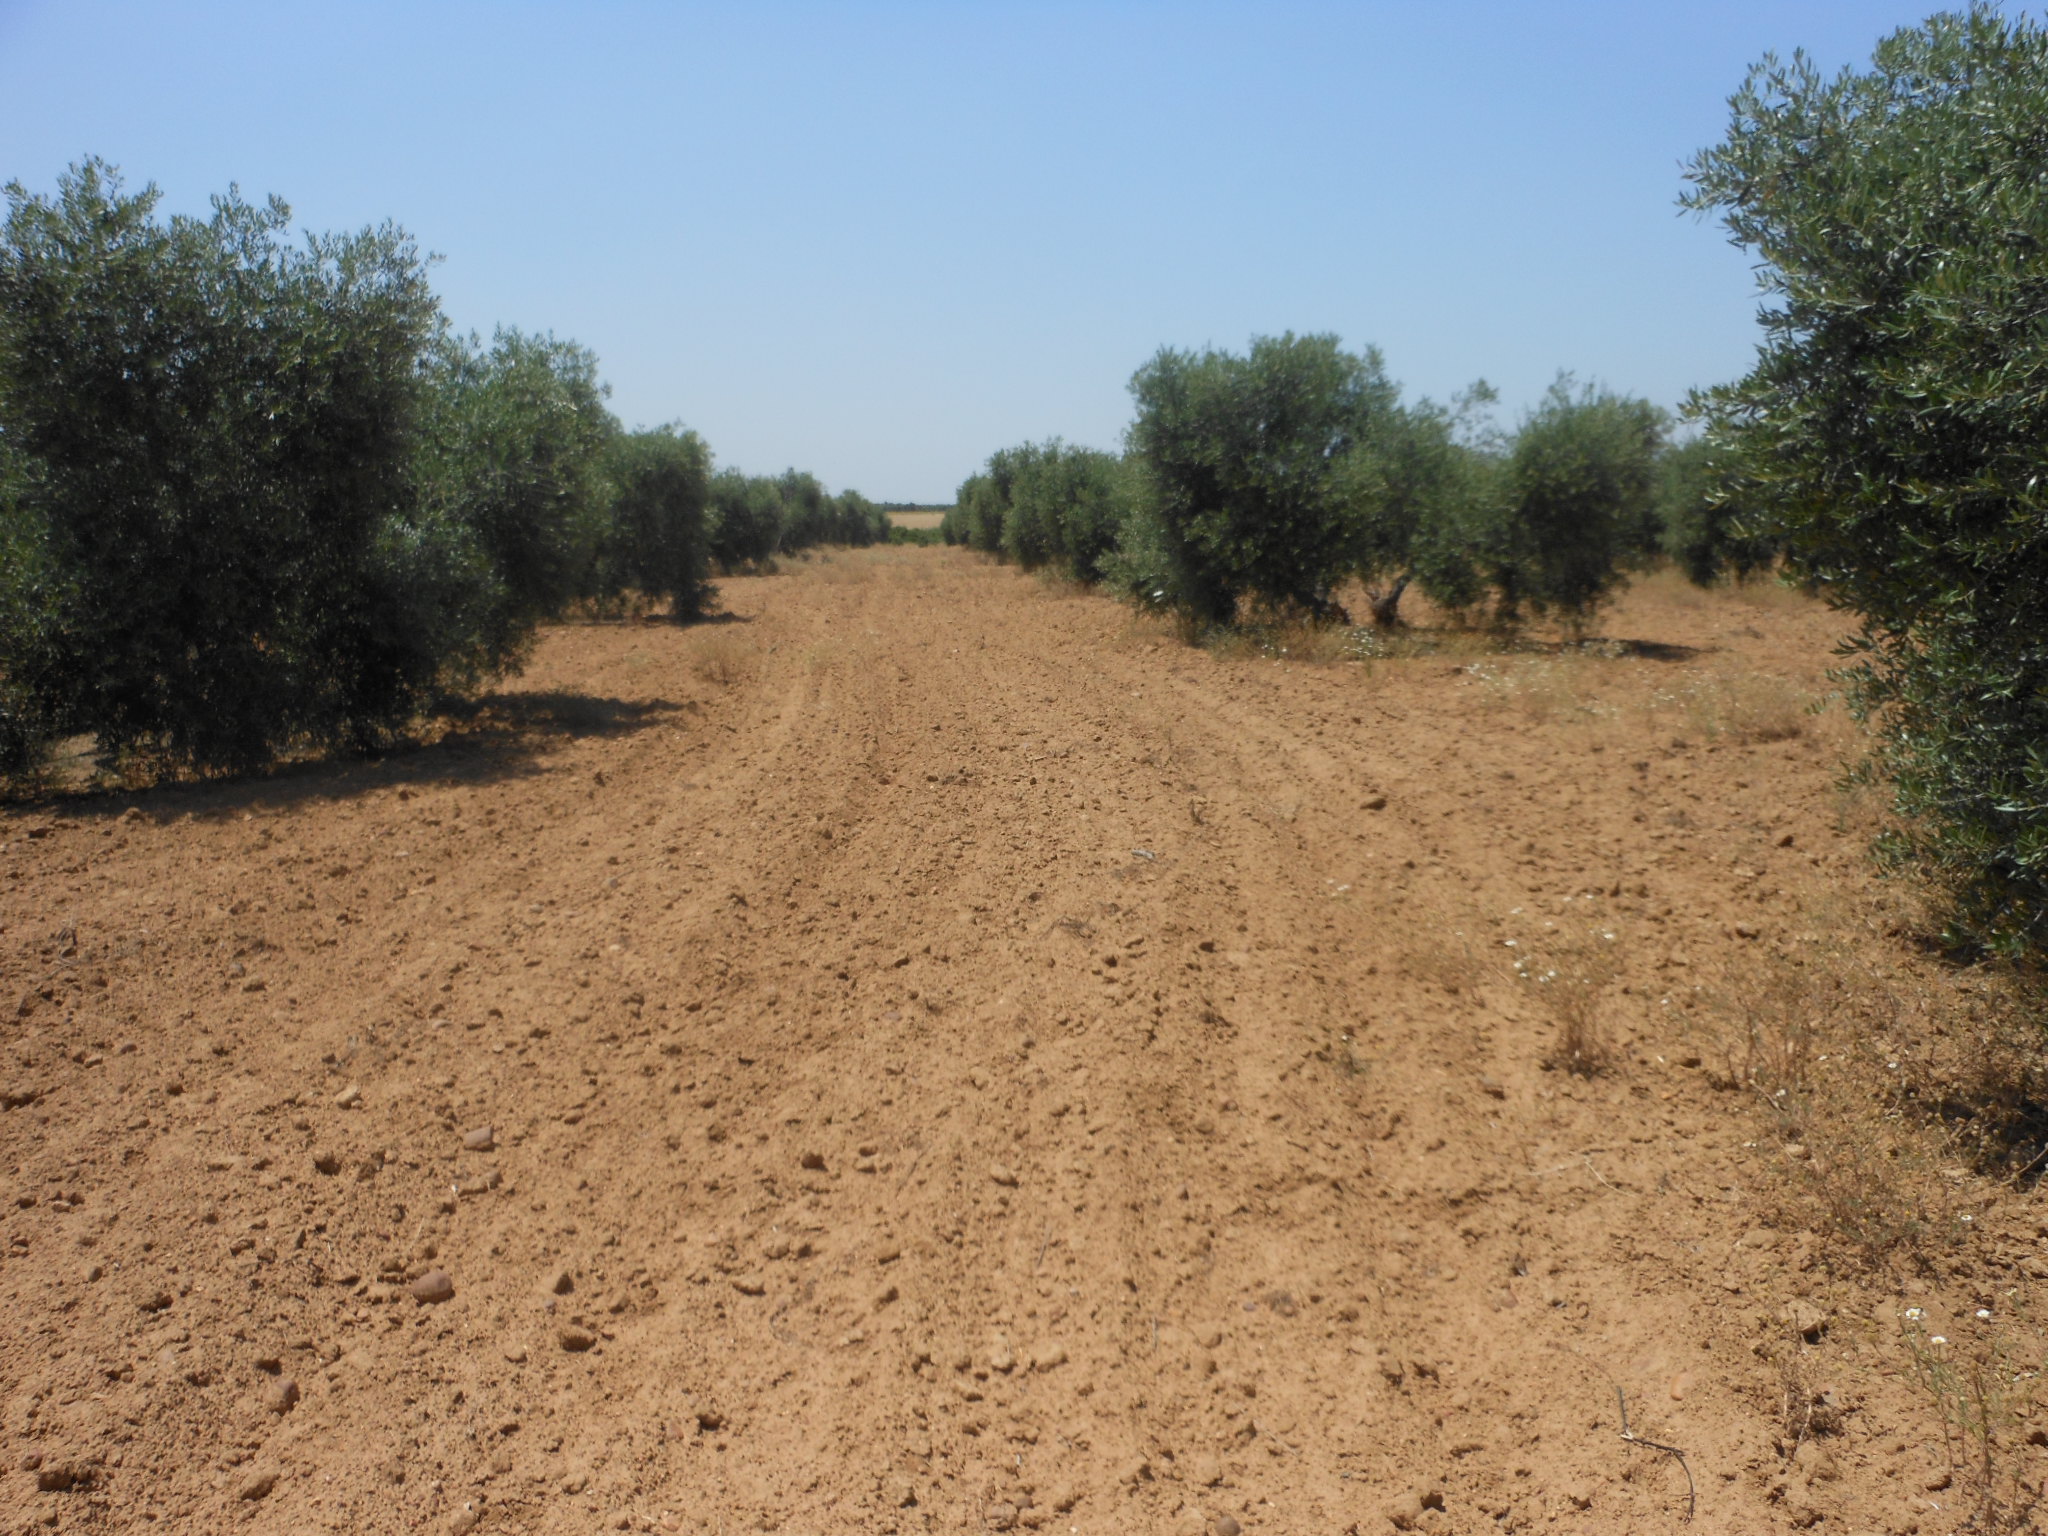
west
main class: Cropland
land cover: Olive groves
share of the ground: 50 - 75 %
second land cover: Other bare soil
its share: > 75 %
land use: Agriculture (excluding fallow land and kitchen gardens)
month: May
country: ES
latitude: 37.5316
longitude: -5.4188
